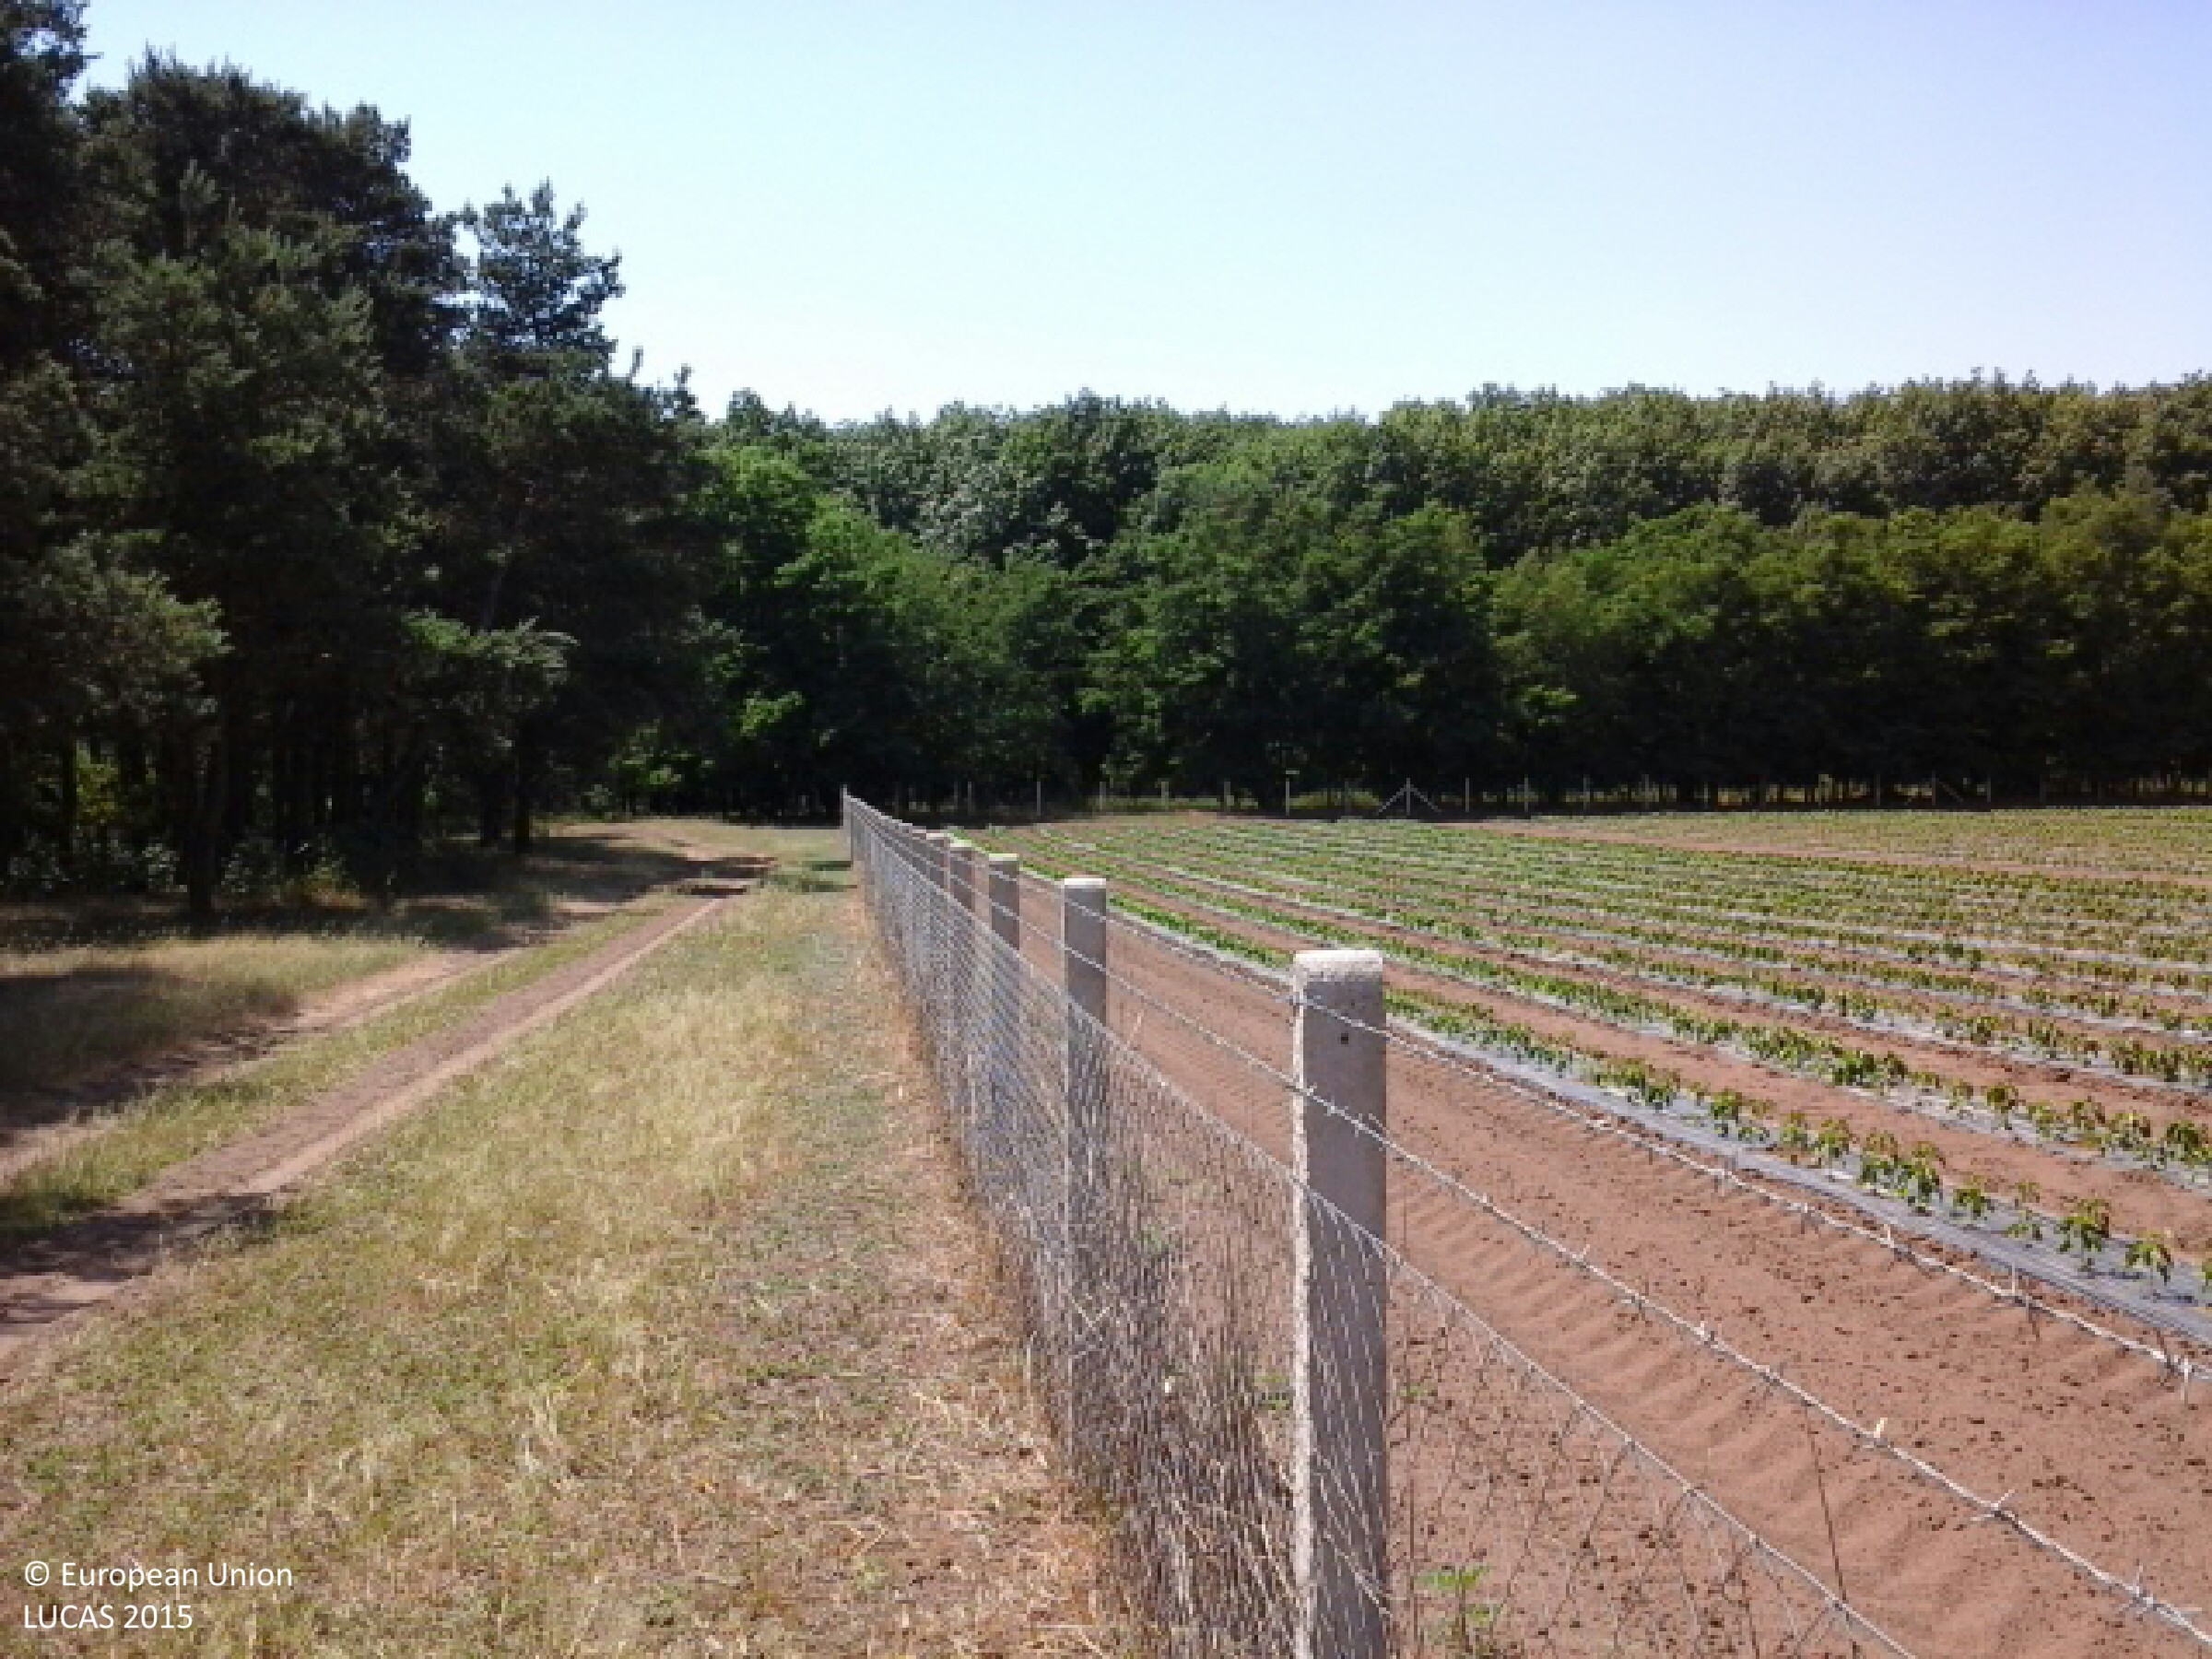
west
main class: Cropland
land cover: Other fresh vegetables
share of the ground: 10 - 25 %
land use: Agriculture (excluding fallow land and kitchen gardens)
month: June
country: HU
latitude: 47.8745
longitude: 21.6656
